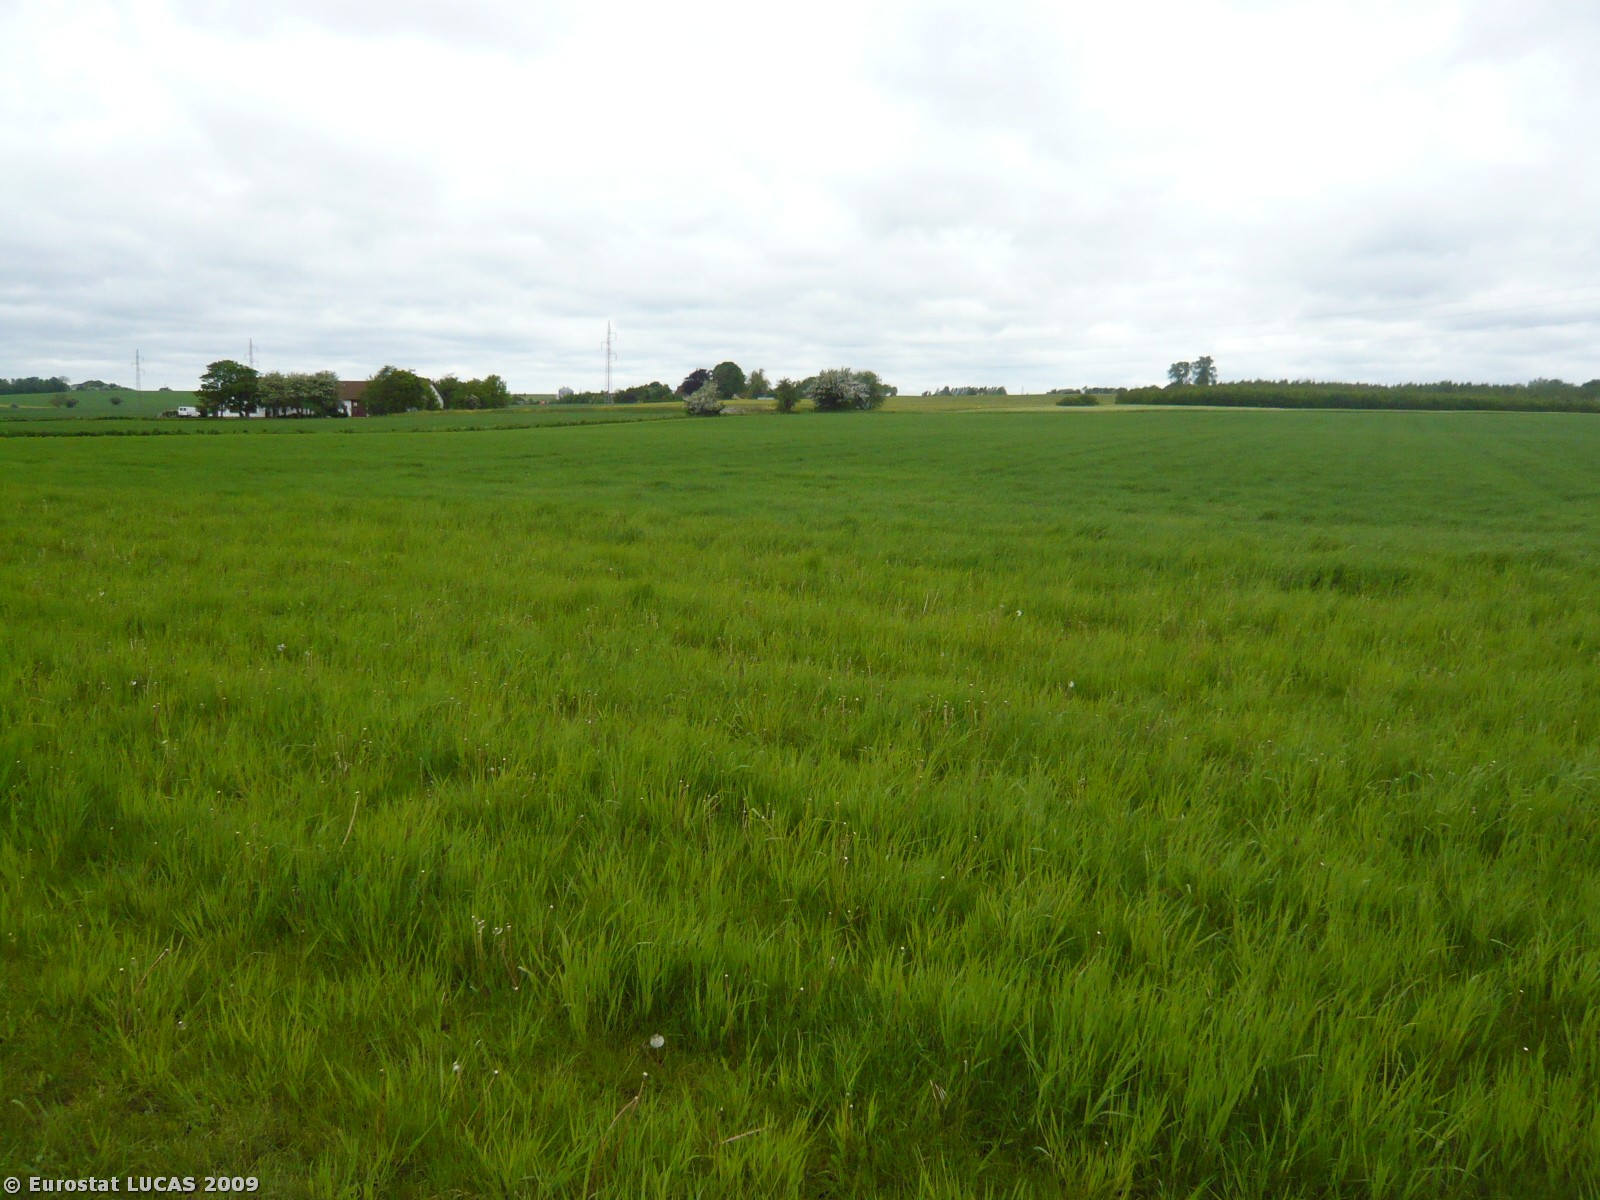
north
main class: Grassland
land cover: Grassland without tree/shrub cover
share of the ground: > 75 %
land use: Agriculture (excluding fallow land and kitchen gardens)
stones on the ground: < 10 %
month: May
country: DK
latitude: 55.4391
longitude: 11.7214
